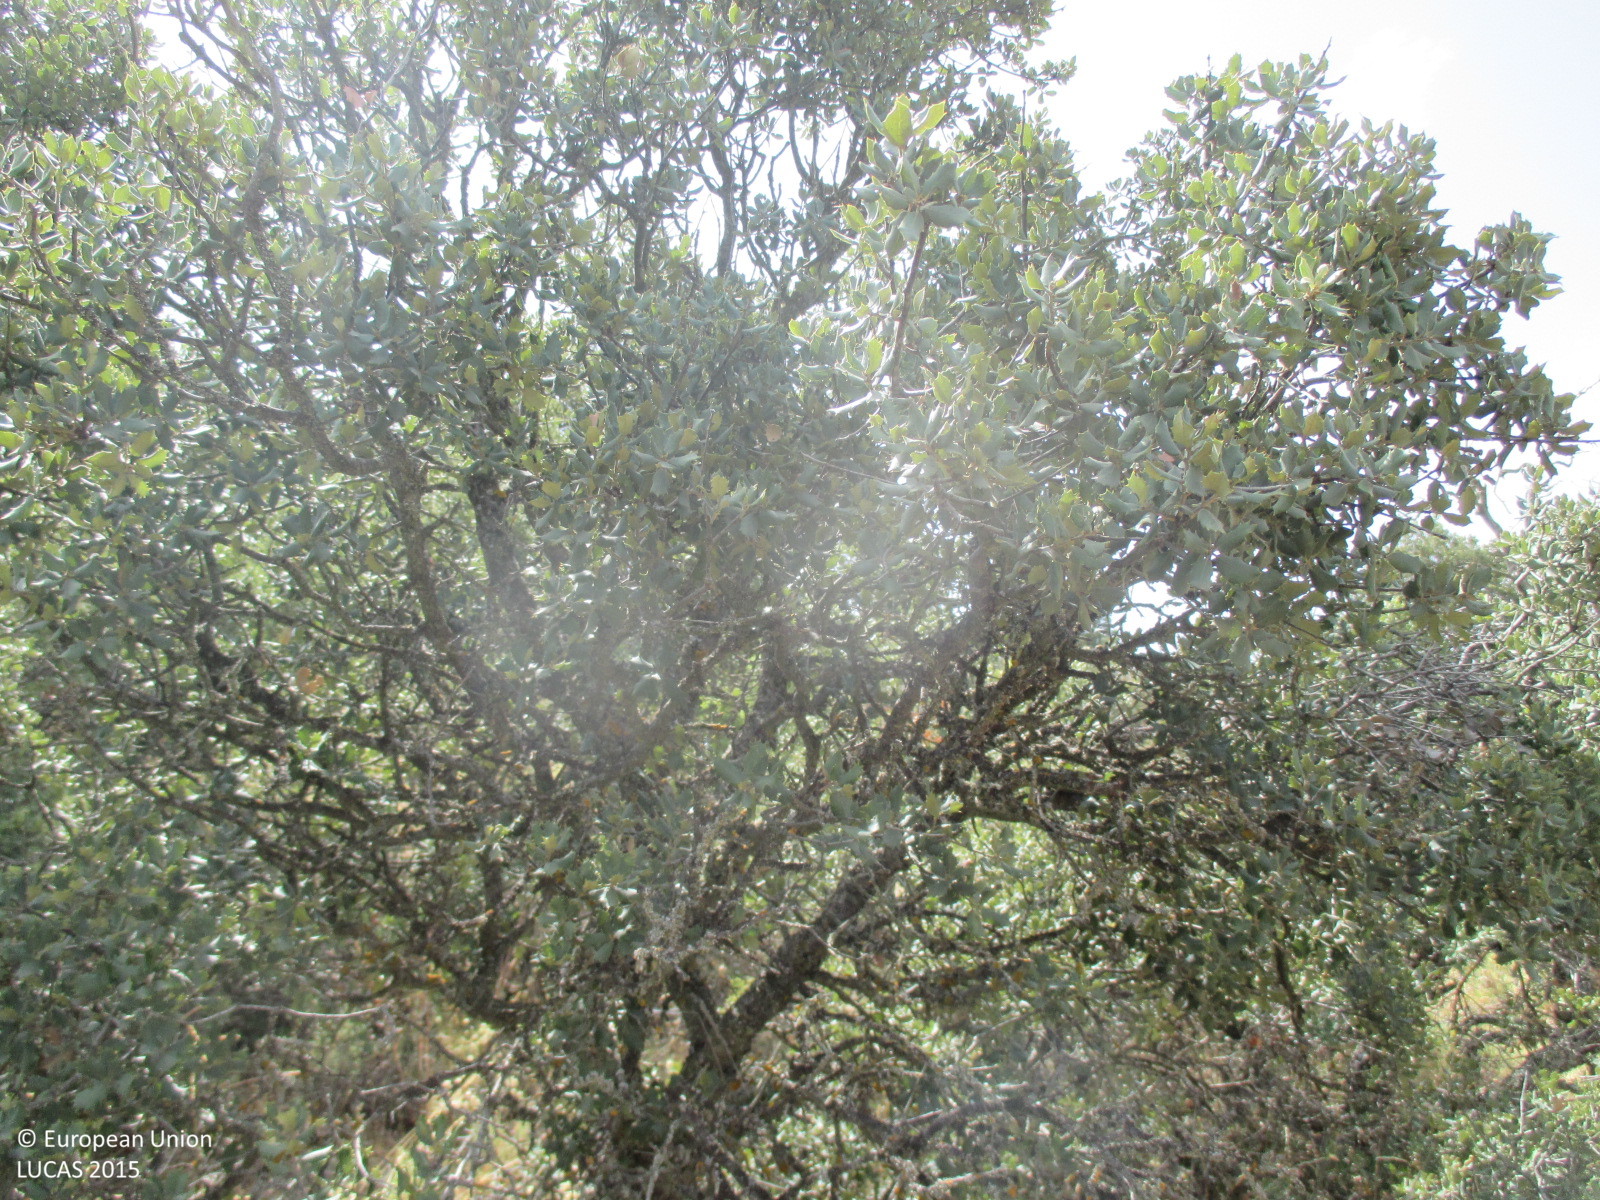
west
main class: Woodland
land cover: Broadleaved woodland
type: broadleaved evergreen forest
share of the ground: 50 - 75 %
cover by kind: broadleaved forest trees 60 %, shrubs 20 %, herbaceous plants 20 %
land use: Semi-natural and natural areas not in use
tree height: < 5 m
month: June
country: ES
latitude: 37.6326
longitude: -2.3716
